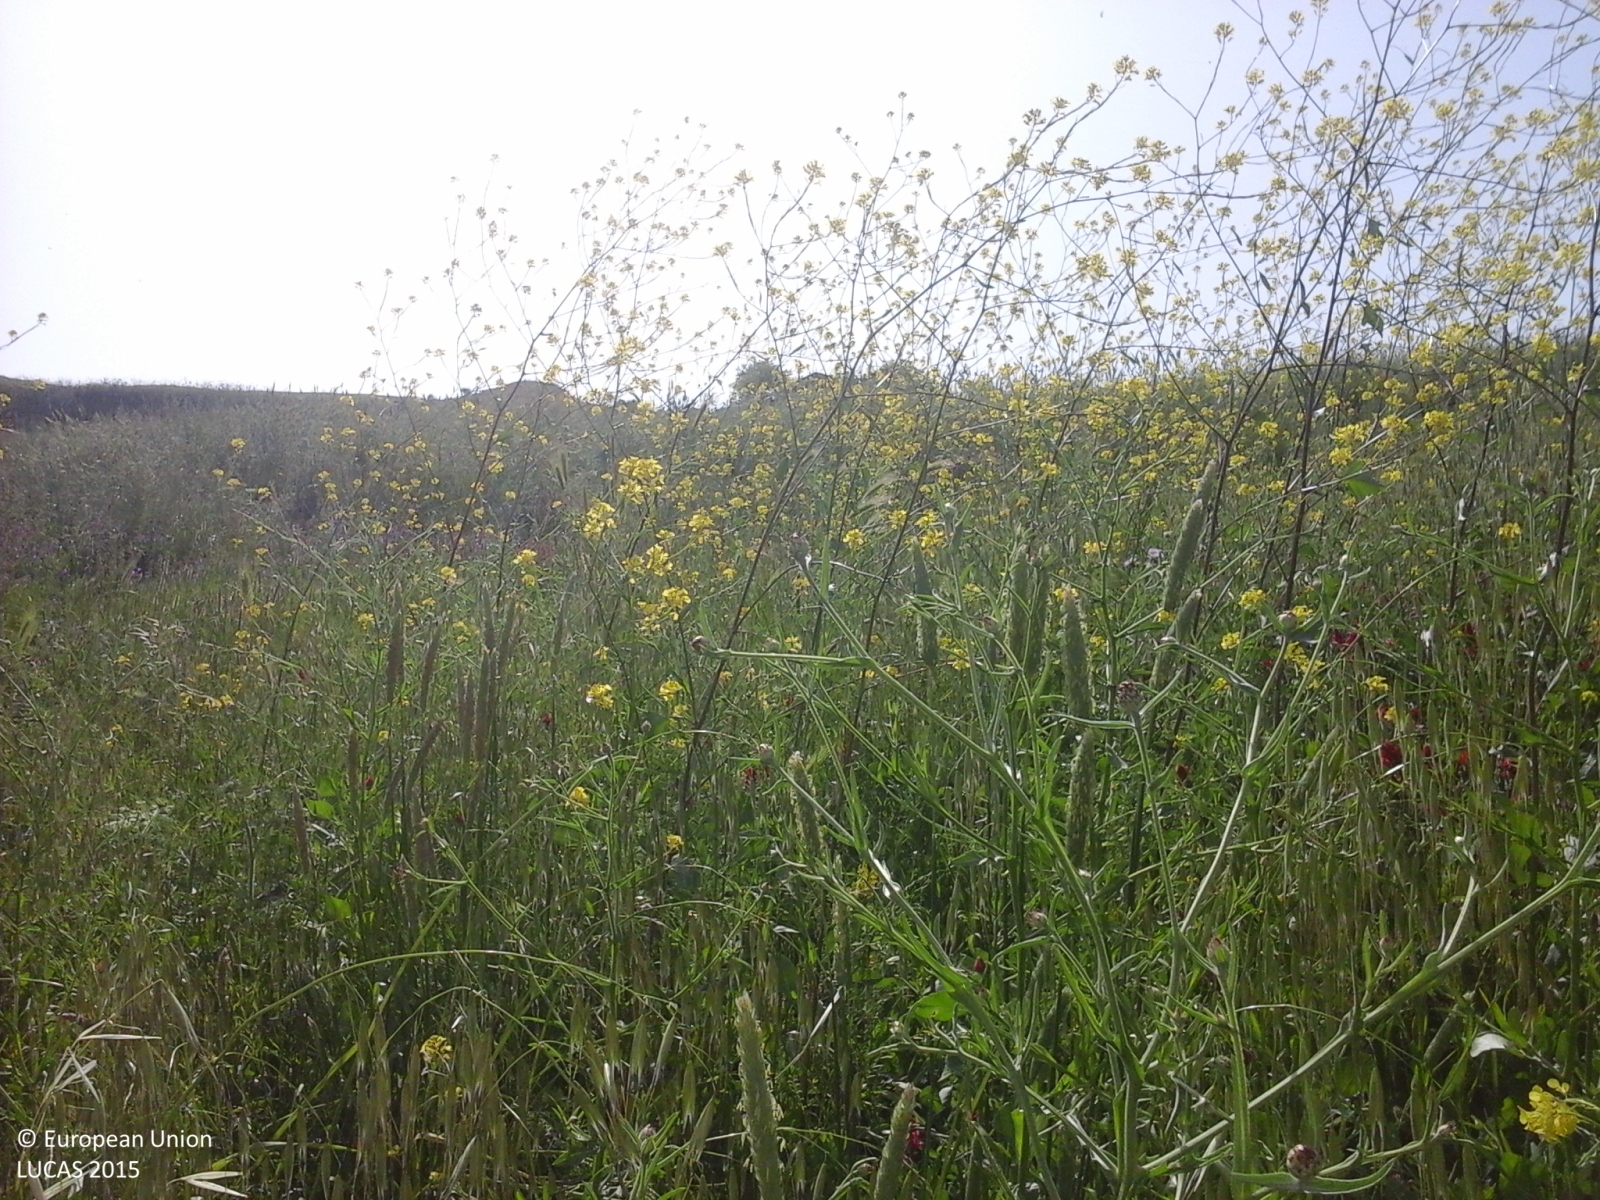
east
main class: Cropland
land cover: Temporary grasslands
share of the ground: > 75 %
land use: Agriculture (excluding fallow land and kitchen gardens)
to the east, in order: Temporary grasslands; Grassland without tree/shrub cover; Ditches and canals; Grassland without tree/shrub cover; Tracks; Grassland without tree/shrub cover; Temporary grasslands
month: May
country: IT
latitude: 37.7303
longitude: 14.1344
